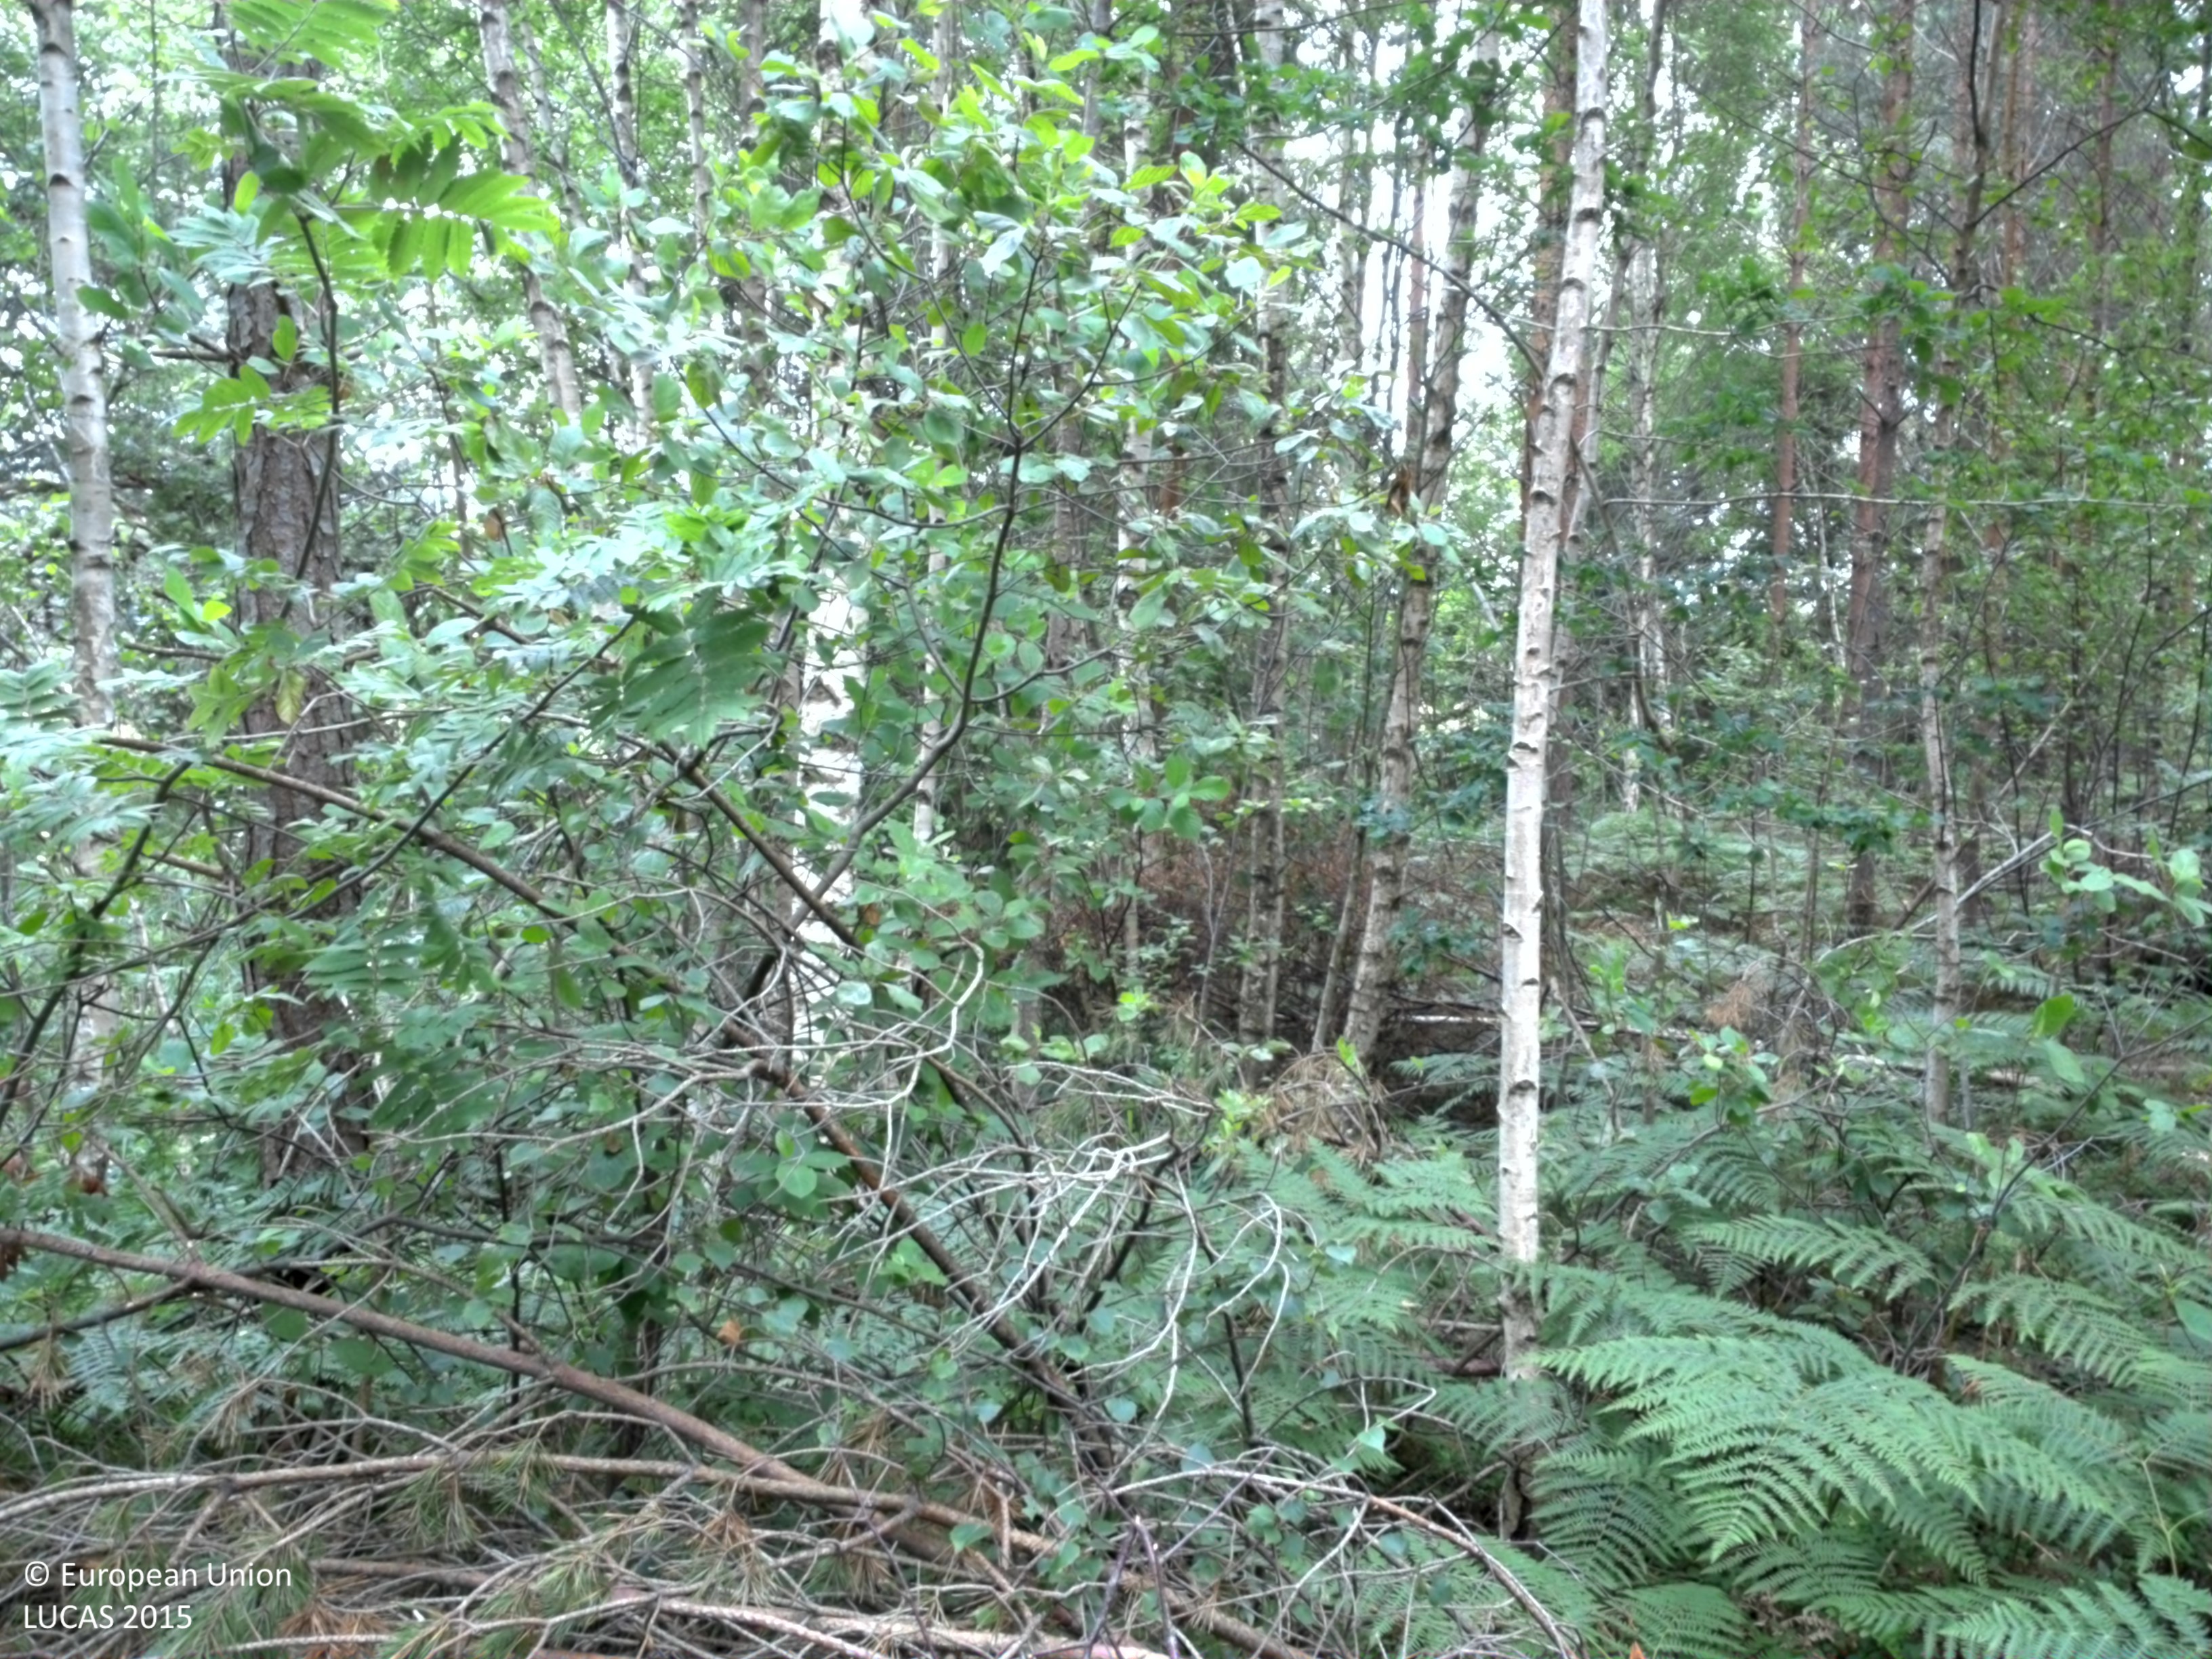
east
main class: Woodland
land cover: Pine dominated mixed woodland
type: hemiboreal forest and nemoral coniferous forest and mixed broadleaved-coniferous forest
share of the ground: > 75 %
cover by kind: coniferous forest trees 55 %, broadleaved forest trees 25 %, shrubs 15 %, herbaceous plants 5 %
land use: Forestry
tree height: > 5 m
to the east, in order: Pine dominated mixed woodland; Inland marshes; Pine dominated mixed woodland
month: July
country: SE
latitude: 57.4765
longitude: 18.2621
